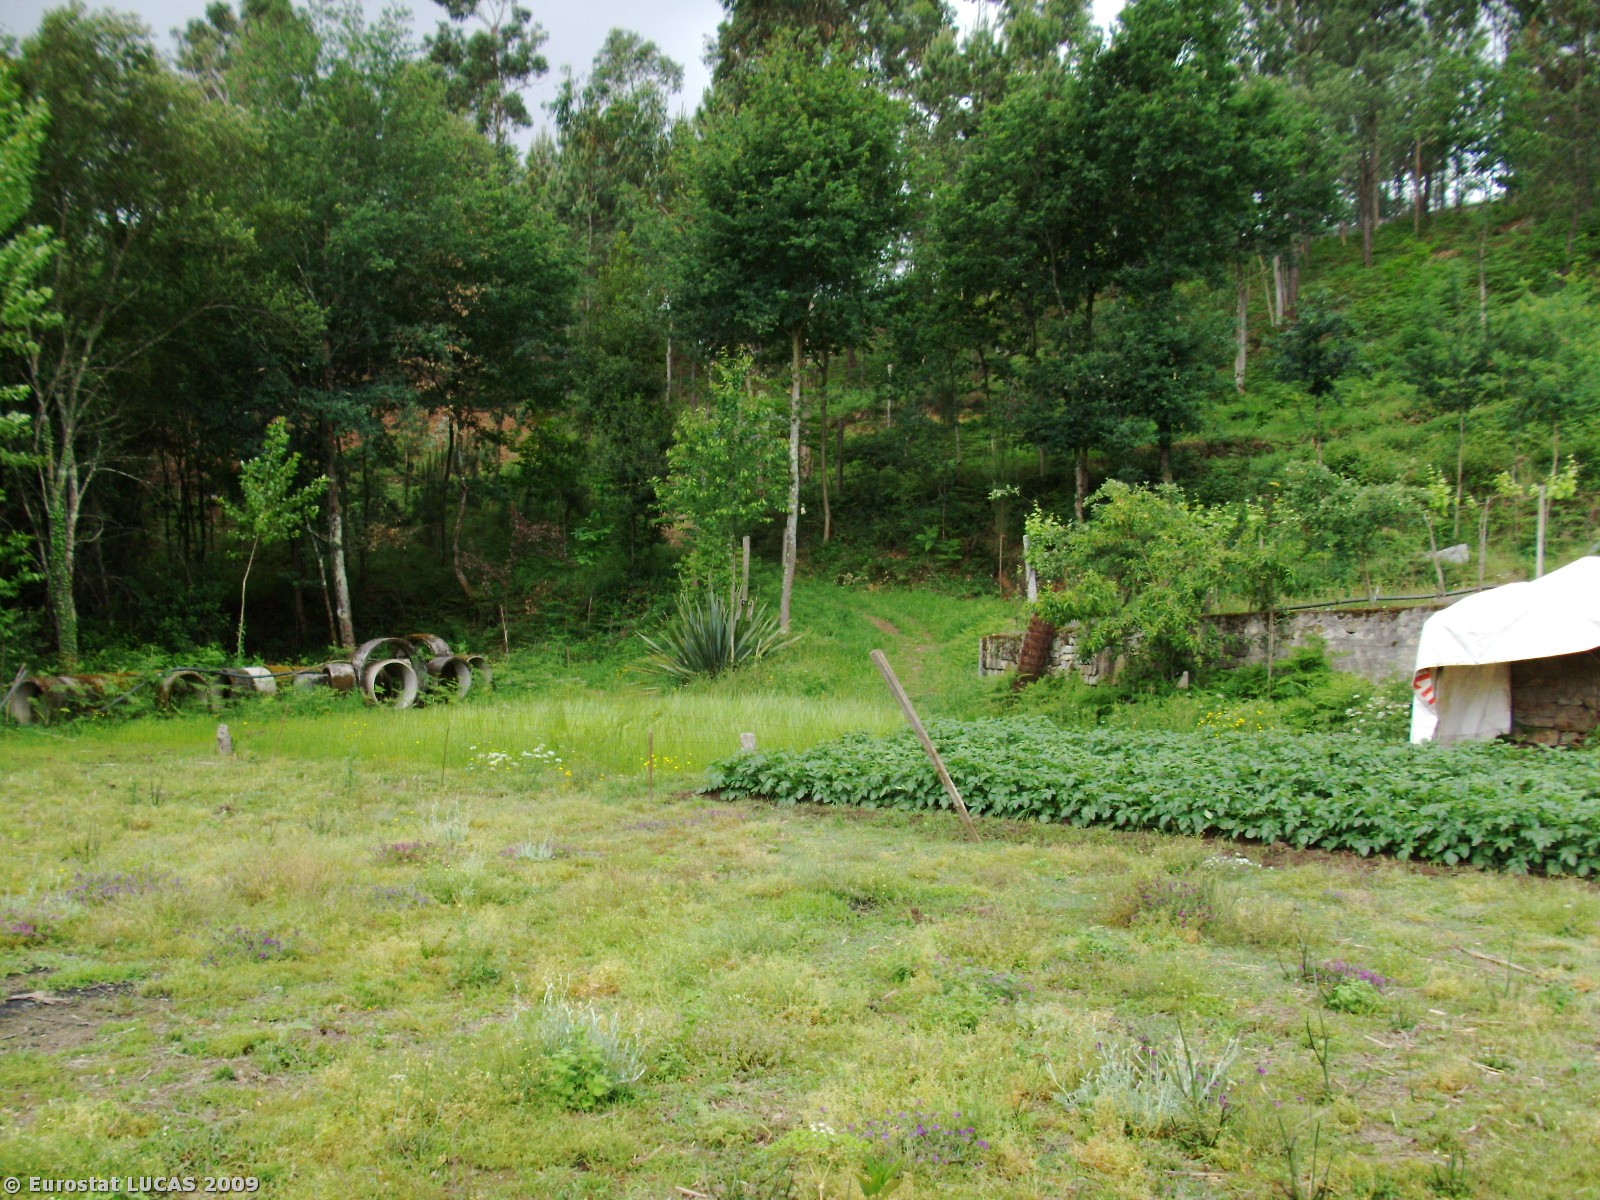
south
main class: Grassland
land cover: Spontaneously vegetated surfaces
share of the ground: > 75 %
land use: Fallow land
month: May
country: PT
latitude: 41.5928
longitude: -8.5243
